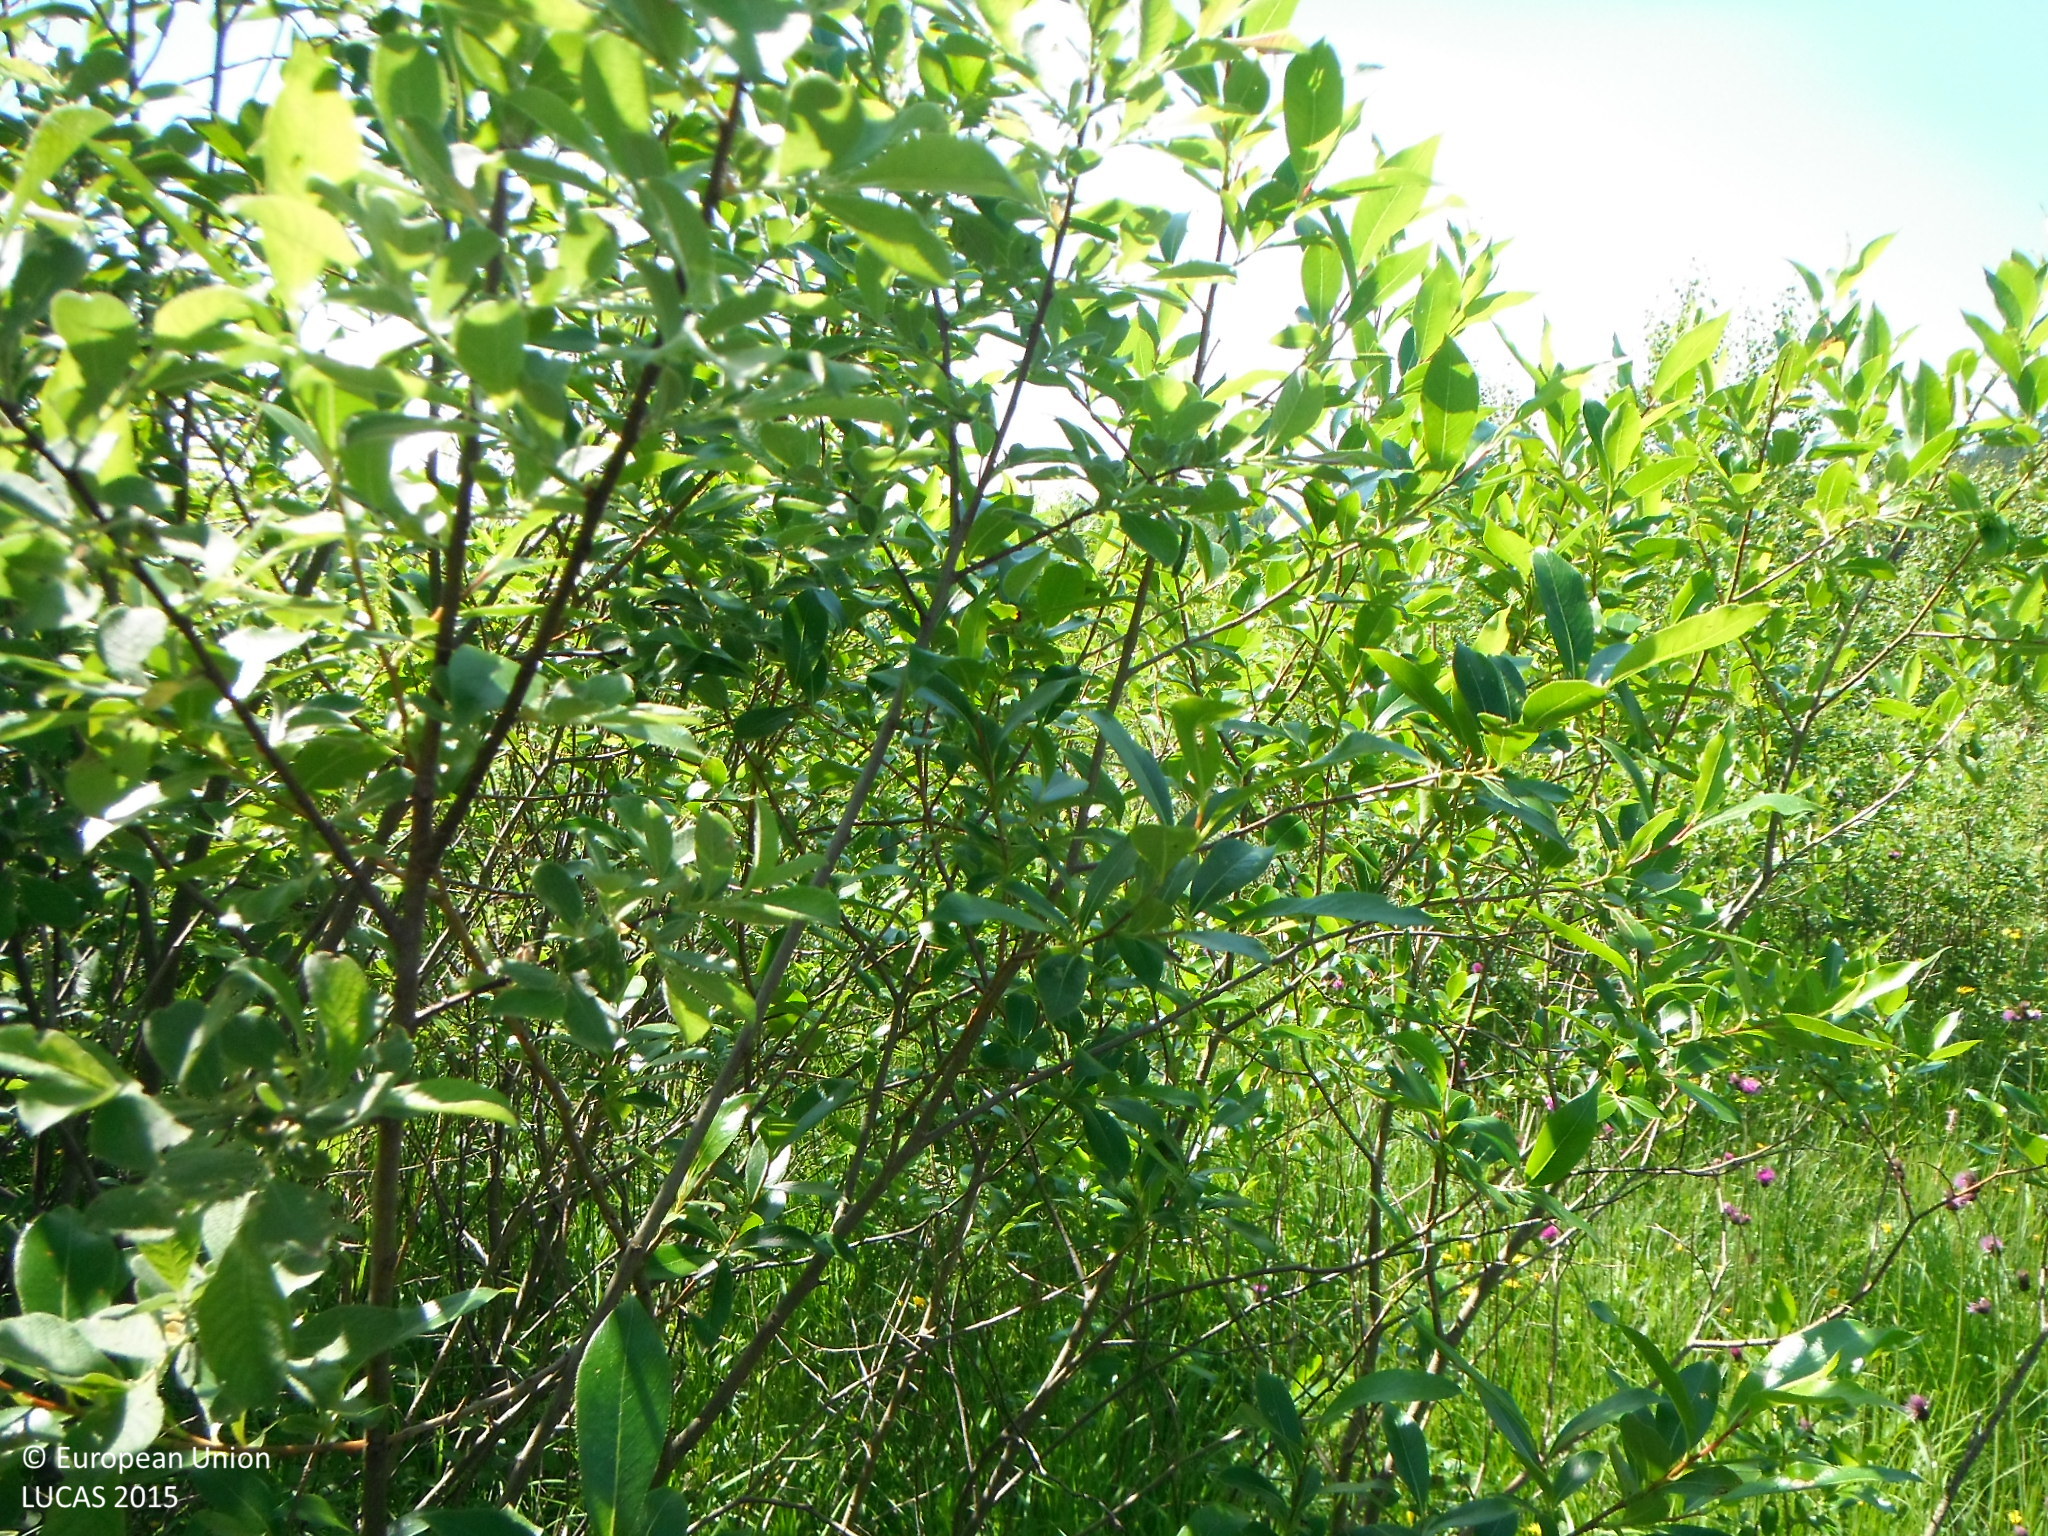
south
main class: Shrubland
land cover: Shrubland without tree cover
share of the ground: > 75 %
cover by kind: shrubs 80 %, herbaceous plants 20 %
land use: Semi-natural and natural areas not in use
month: July
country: SK
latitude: 49.4207
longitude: 19.3303
